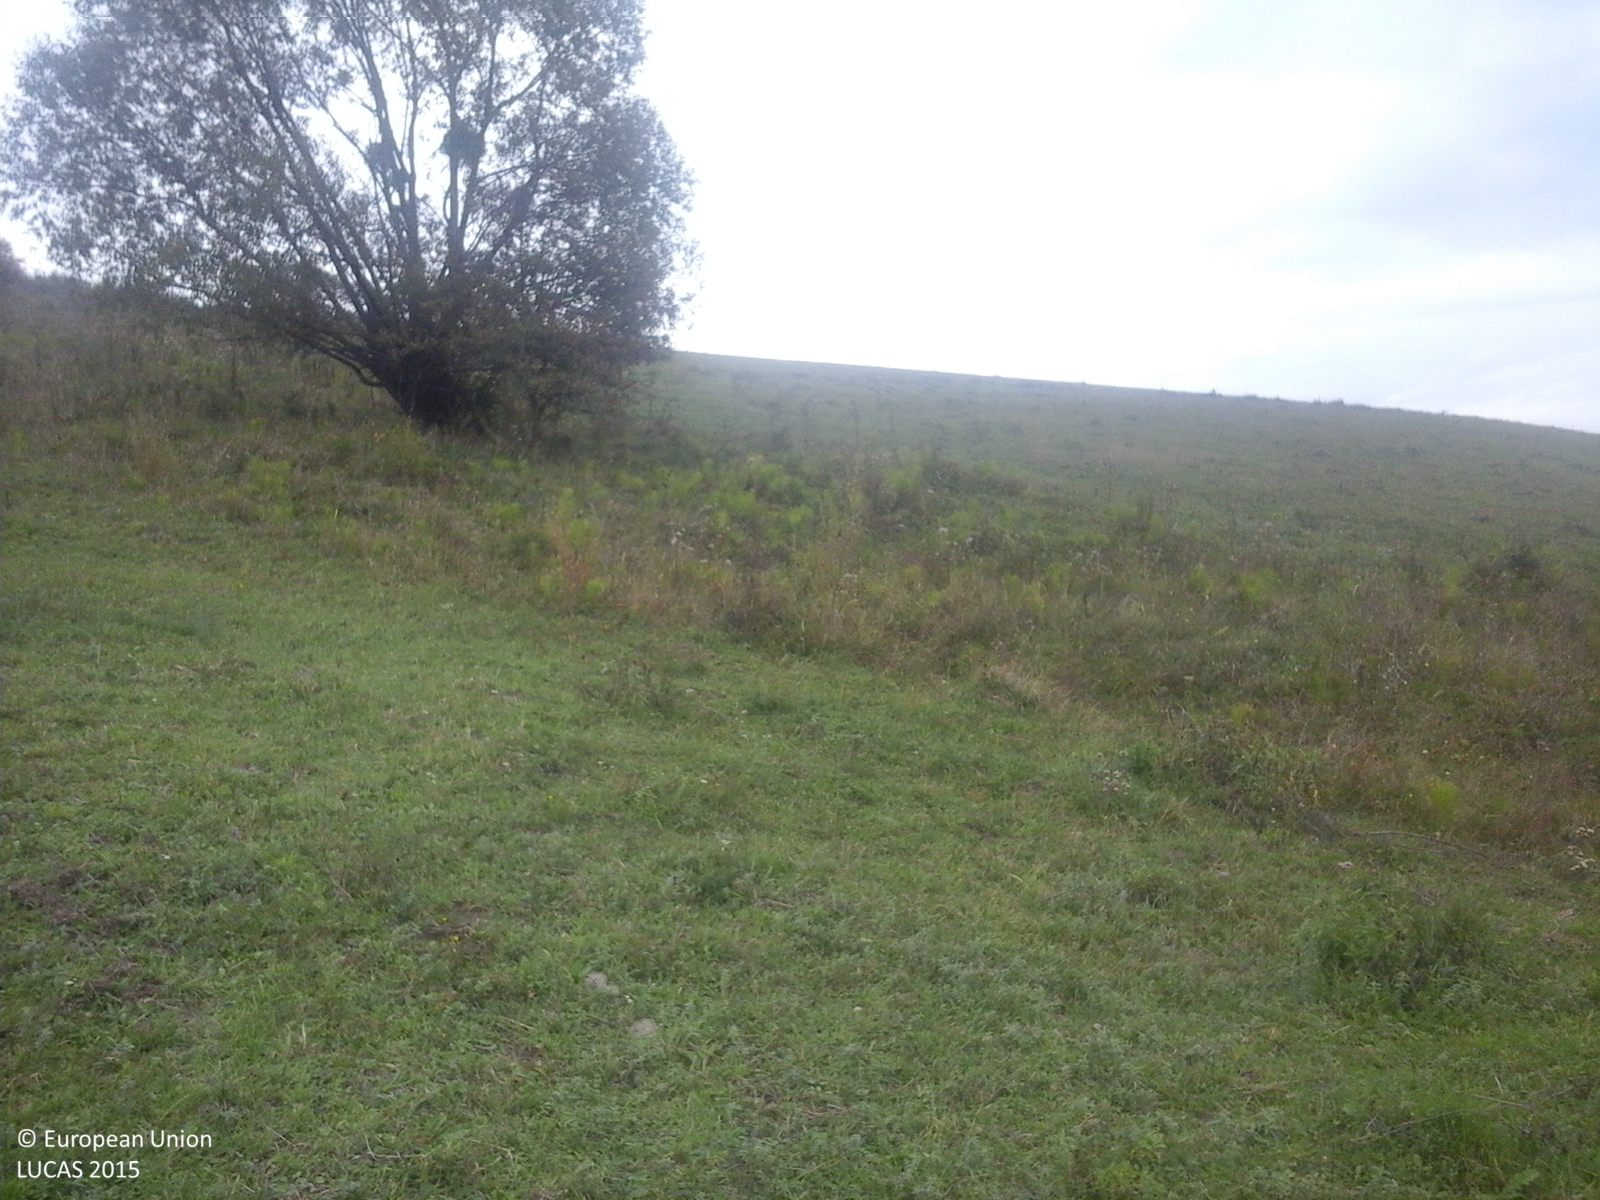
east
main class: Grassland
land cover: Grassland without tree/shrub cover
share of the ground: > 75 %
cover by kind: herbaceous plants 100 %
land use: Agriculture (excluding fallow land and kitchen gardens)
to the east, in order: Grassland without tree/shrub cover; Shrubland with sparse tree cover; Spontaneously vegetated surfaces; Shrubland with sparse tree cover; Spontaneously vegetated surfaces
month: October
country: RO
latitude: 46.4573
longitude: 24.8721
